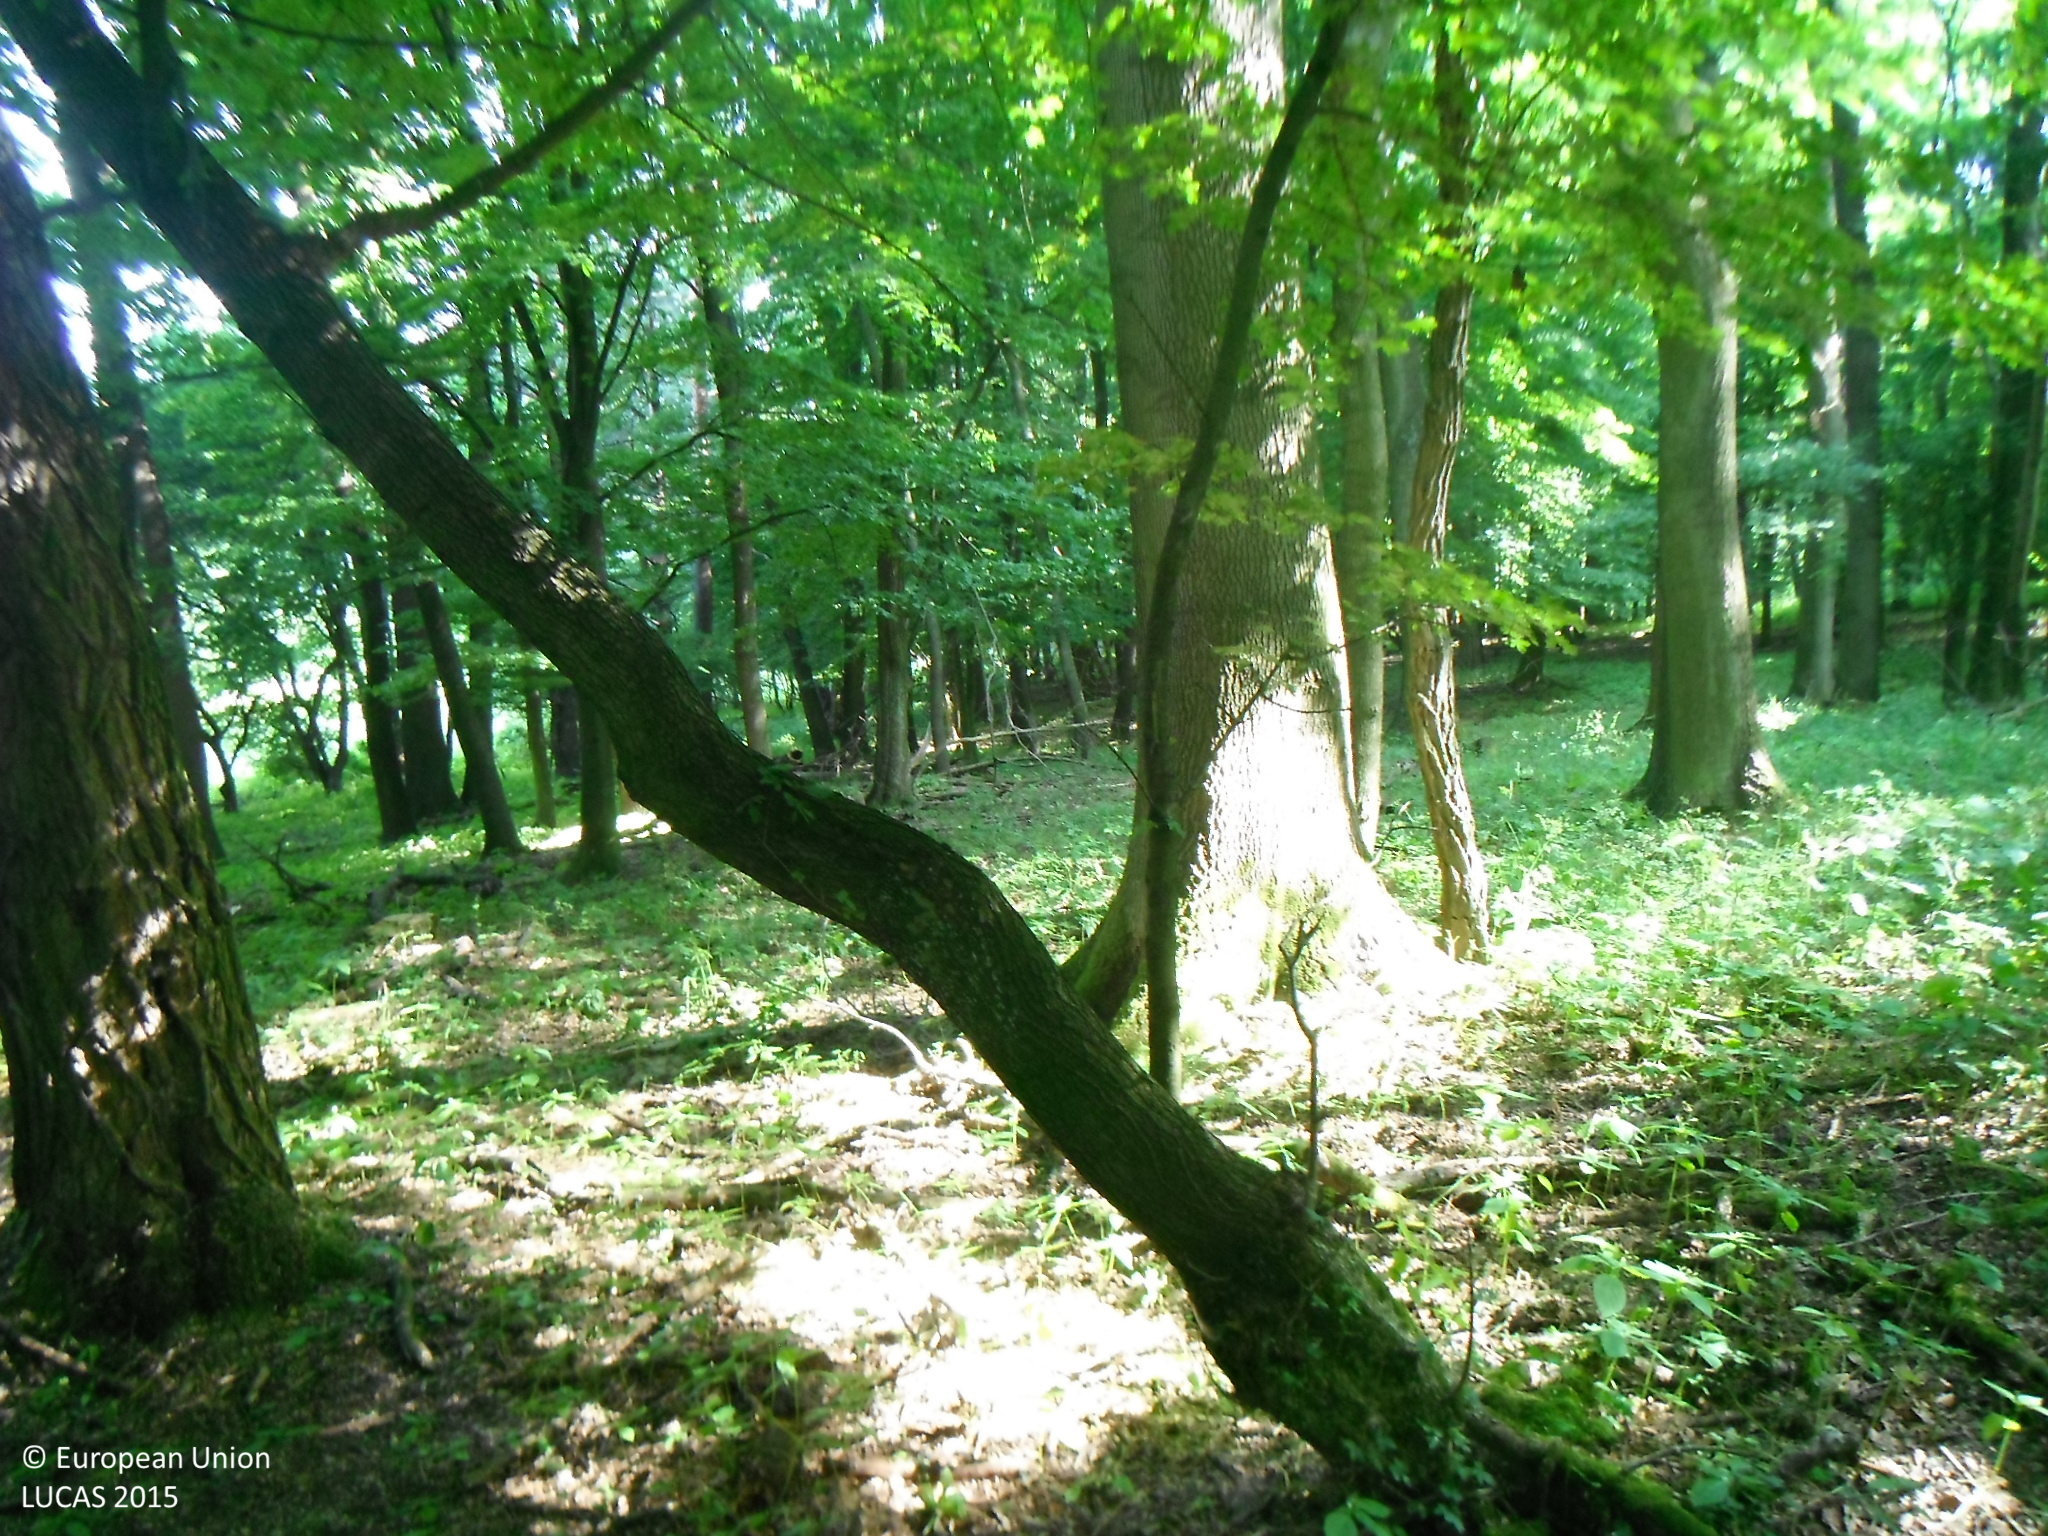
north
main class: Woodland
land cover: Broadleaved woodland
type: mesophytic deciduous forest
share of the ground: > 75 %
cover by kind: broadleaved forest trees 95 %, herbaceous plants 5 %
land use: Forestry
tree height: > 5 m
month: June
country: SK
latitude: 48.5854
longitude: 17.4531
